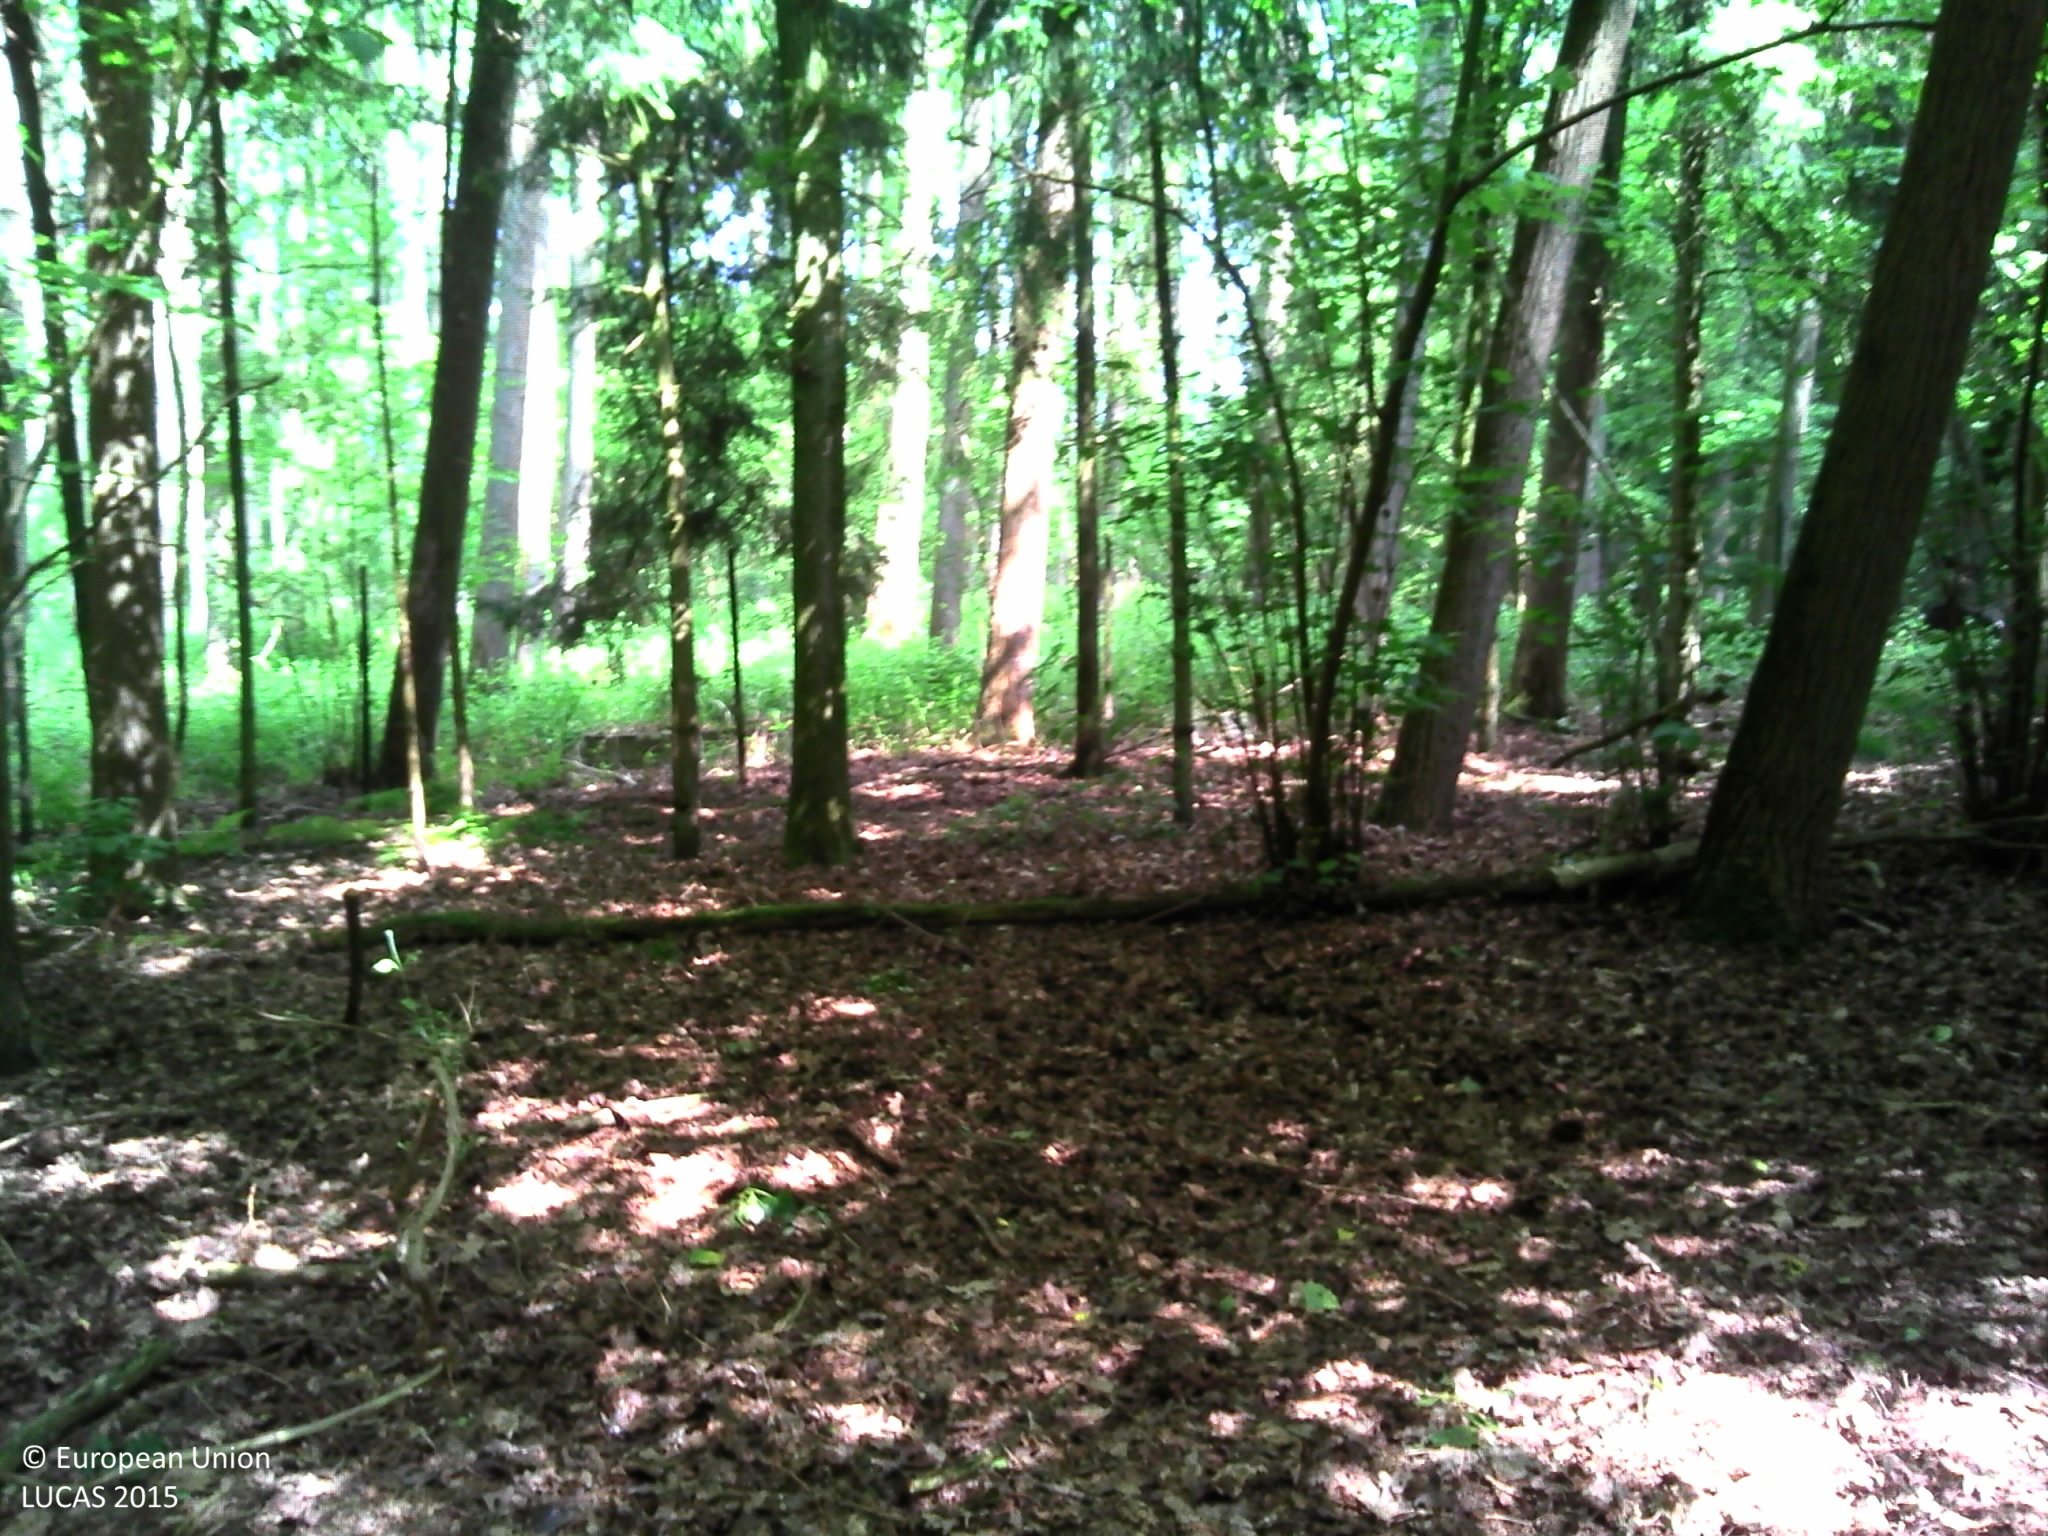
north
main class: Woodland
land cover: Spruce dominated coniferous woodland
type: hemiboreal forest and nemoral coniferous forest and mixed broadleaved-coniferous forest
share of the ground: > 75 %
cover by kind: coniferous forest trees 100 %
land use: Forestry
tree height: > 5 m
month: June
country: BE
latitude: 50.9400
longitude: 3.8885
